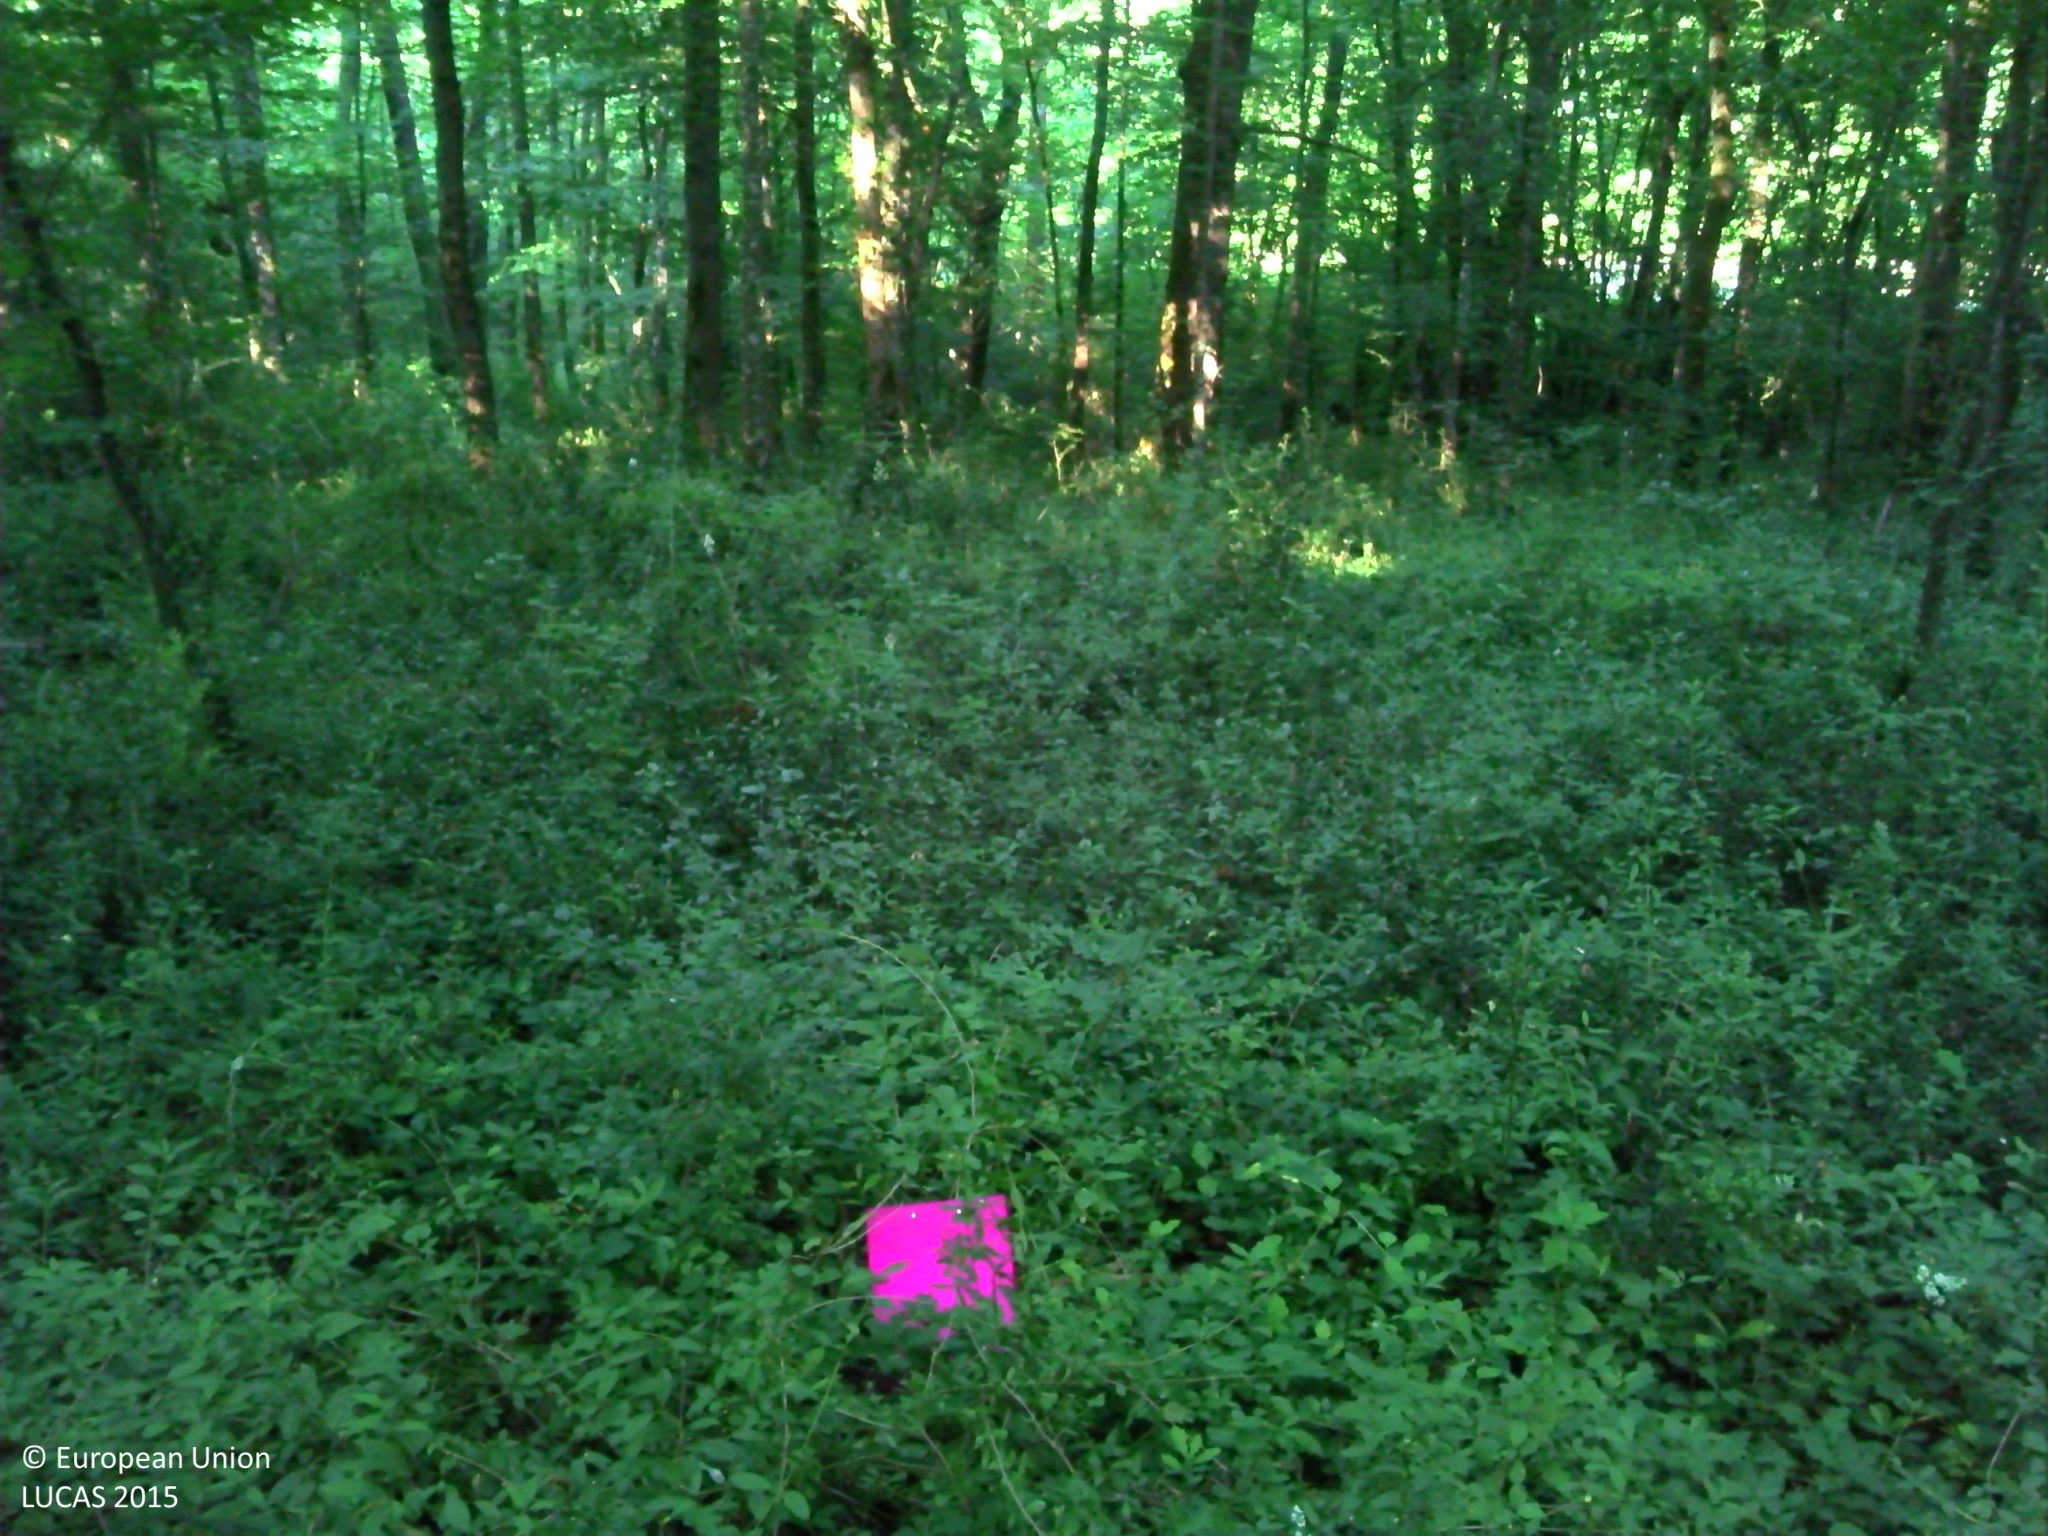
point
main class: Woodland
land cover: Broadleaved woodland
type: mesophytic deciduous forest
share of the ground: > 75 %
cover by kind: broadleaved forest trees 85 %, shrubs 10 %, herbaceous plants 5 %
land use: Forestry
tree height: > 5 m
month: June
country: FR
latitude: 43.6944
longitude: 0.6801
